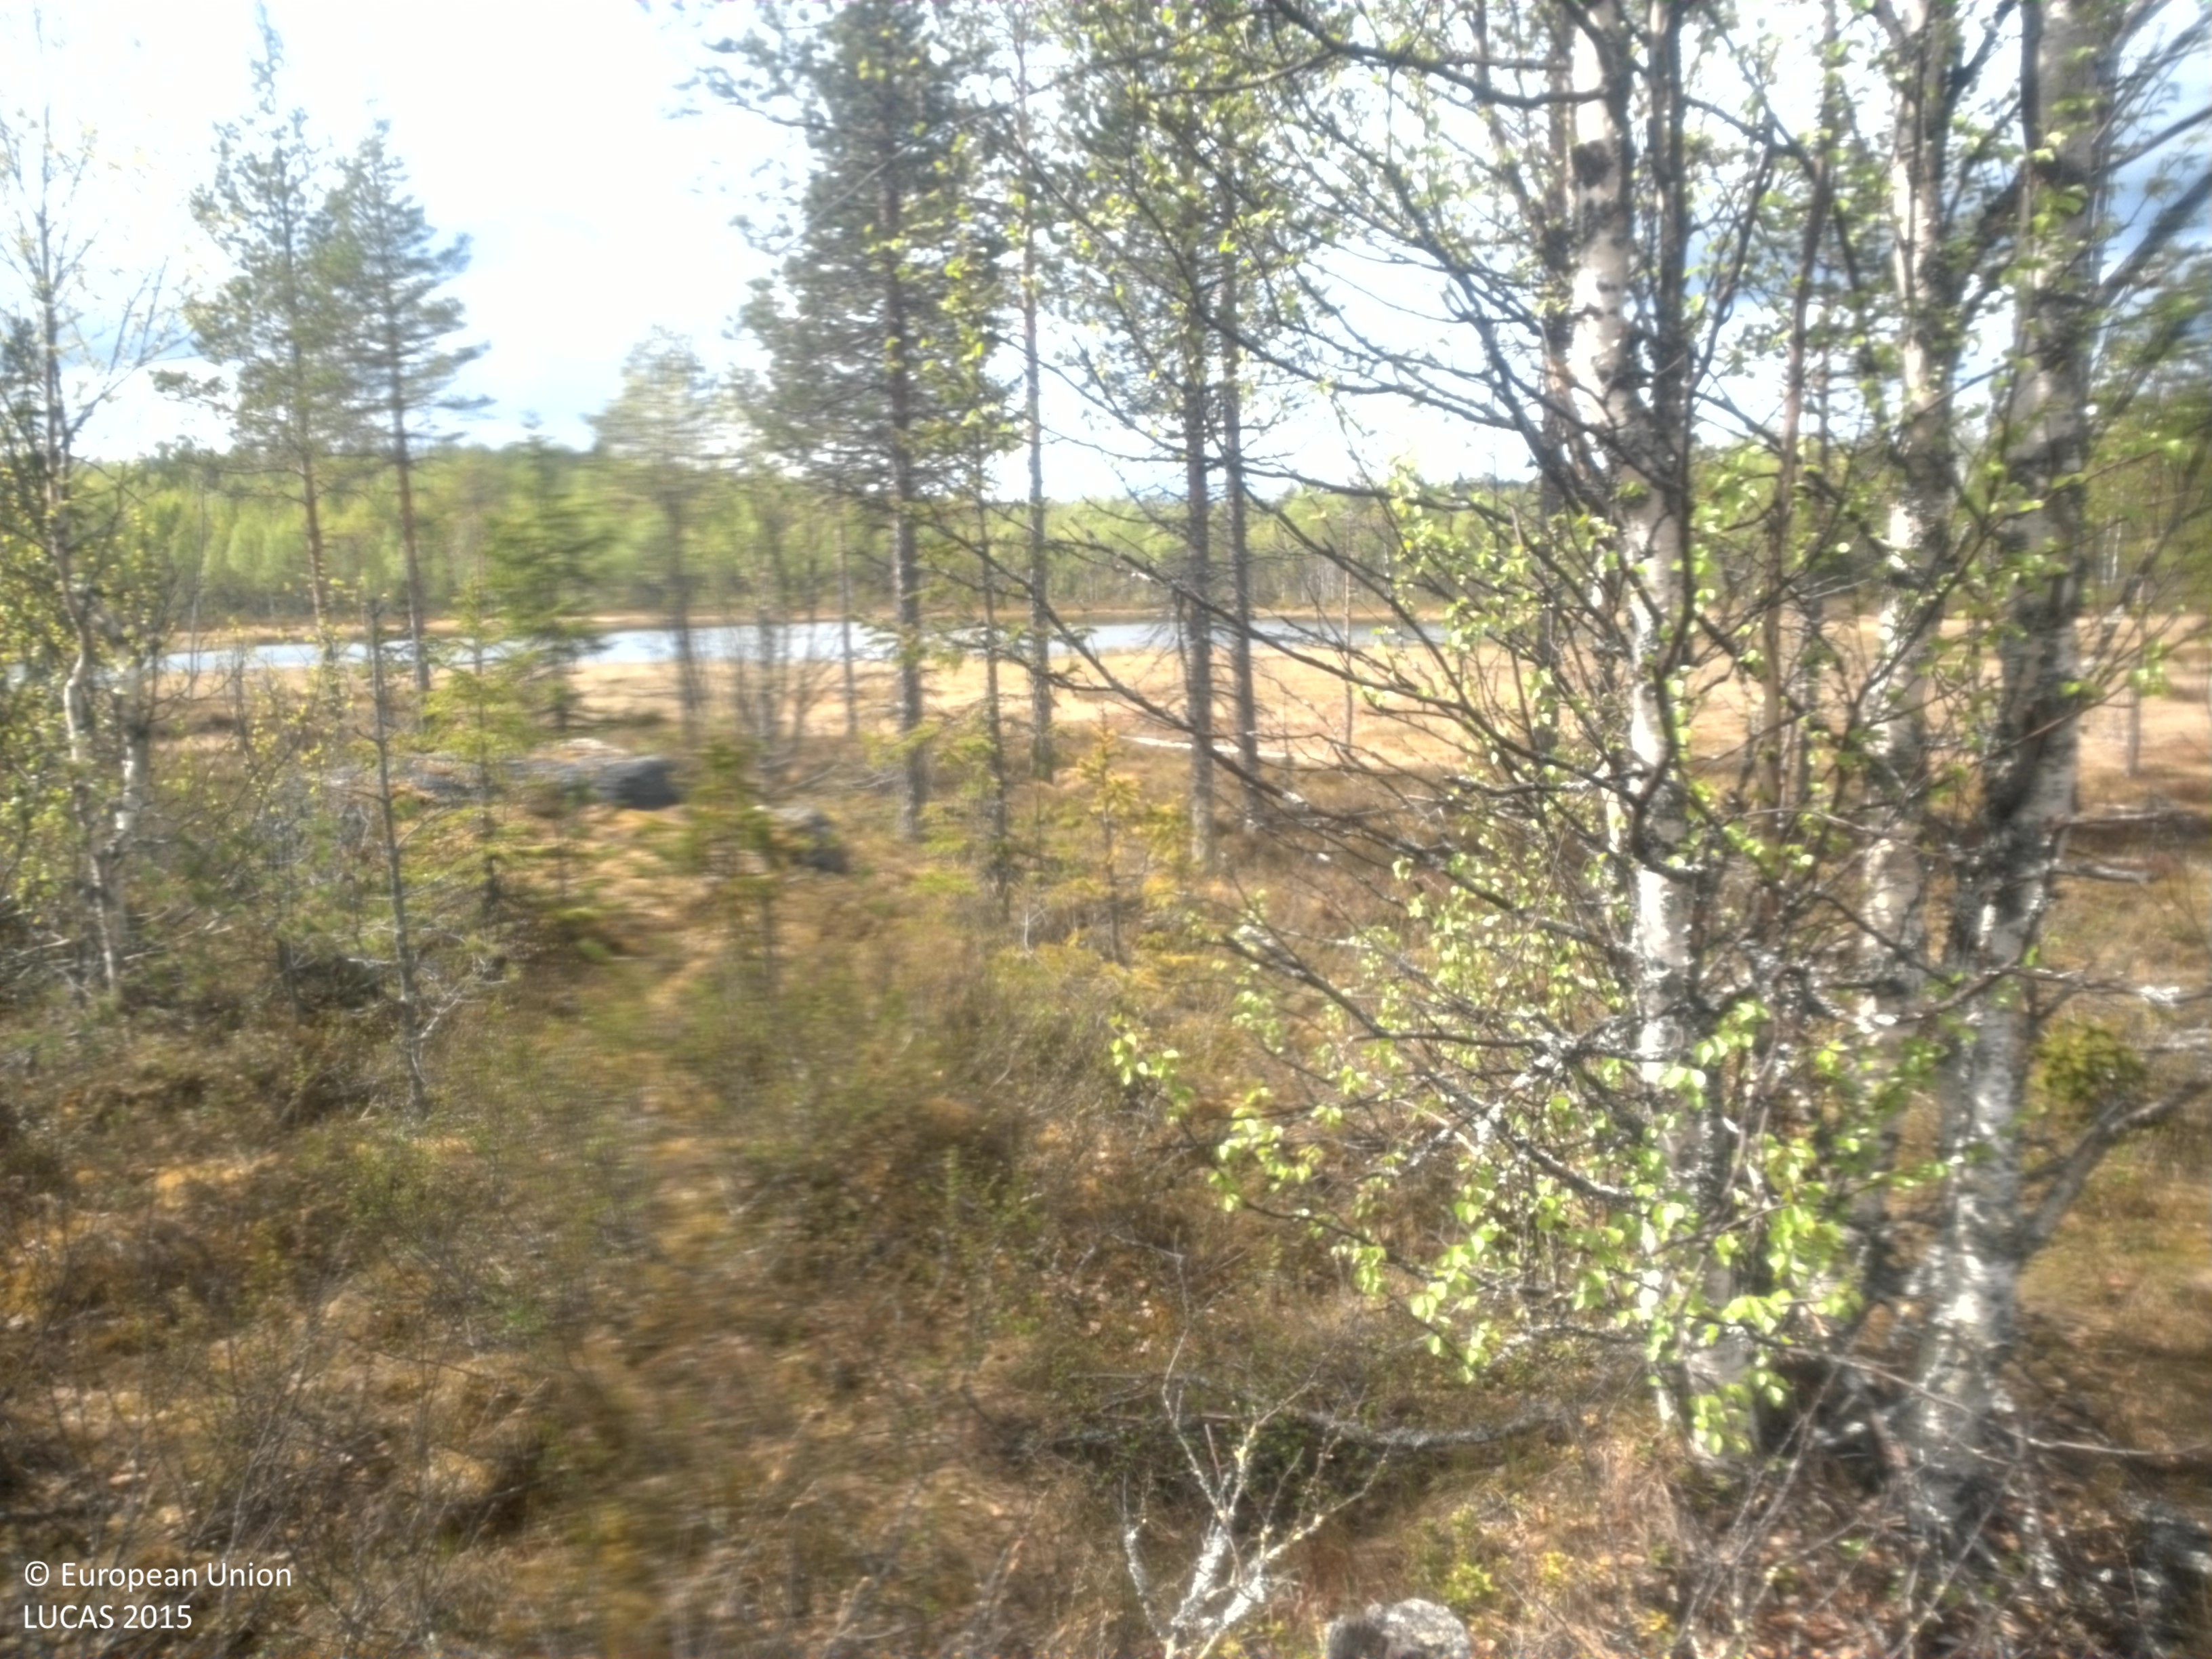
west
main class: Woodland
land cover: Pine dominated mixed woodland
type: boreal forest
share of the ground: 10 - 25 %
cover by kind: shrubs 60 %, herbaceous plants 15 %, coniferous forest trees 10 %, lichens and mosses 10 %, broadleaved forest trees 5 %
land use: Forestry
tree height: < 5 m
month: June
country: SE
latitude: 64.2152
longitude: 17.9847
